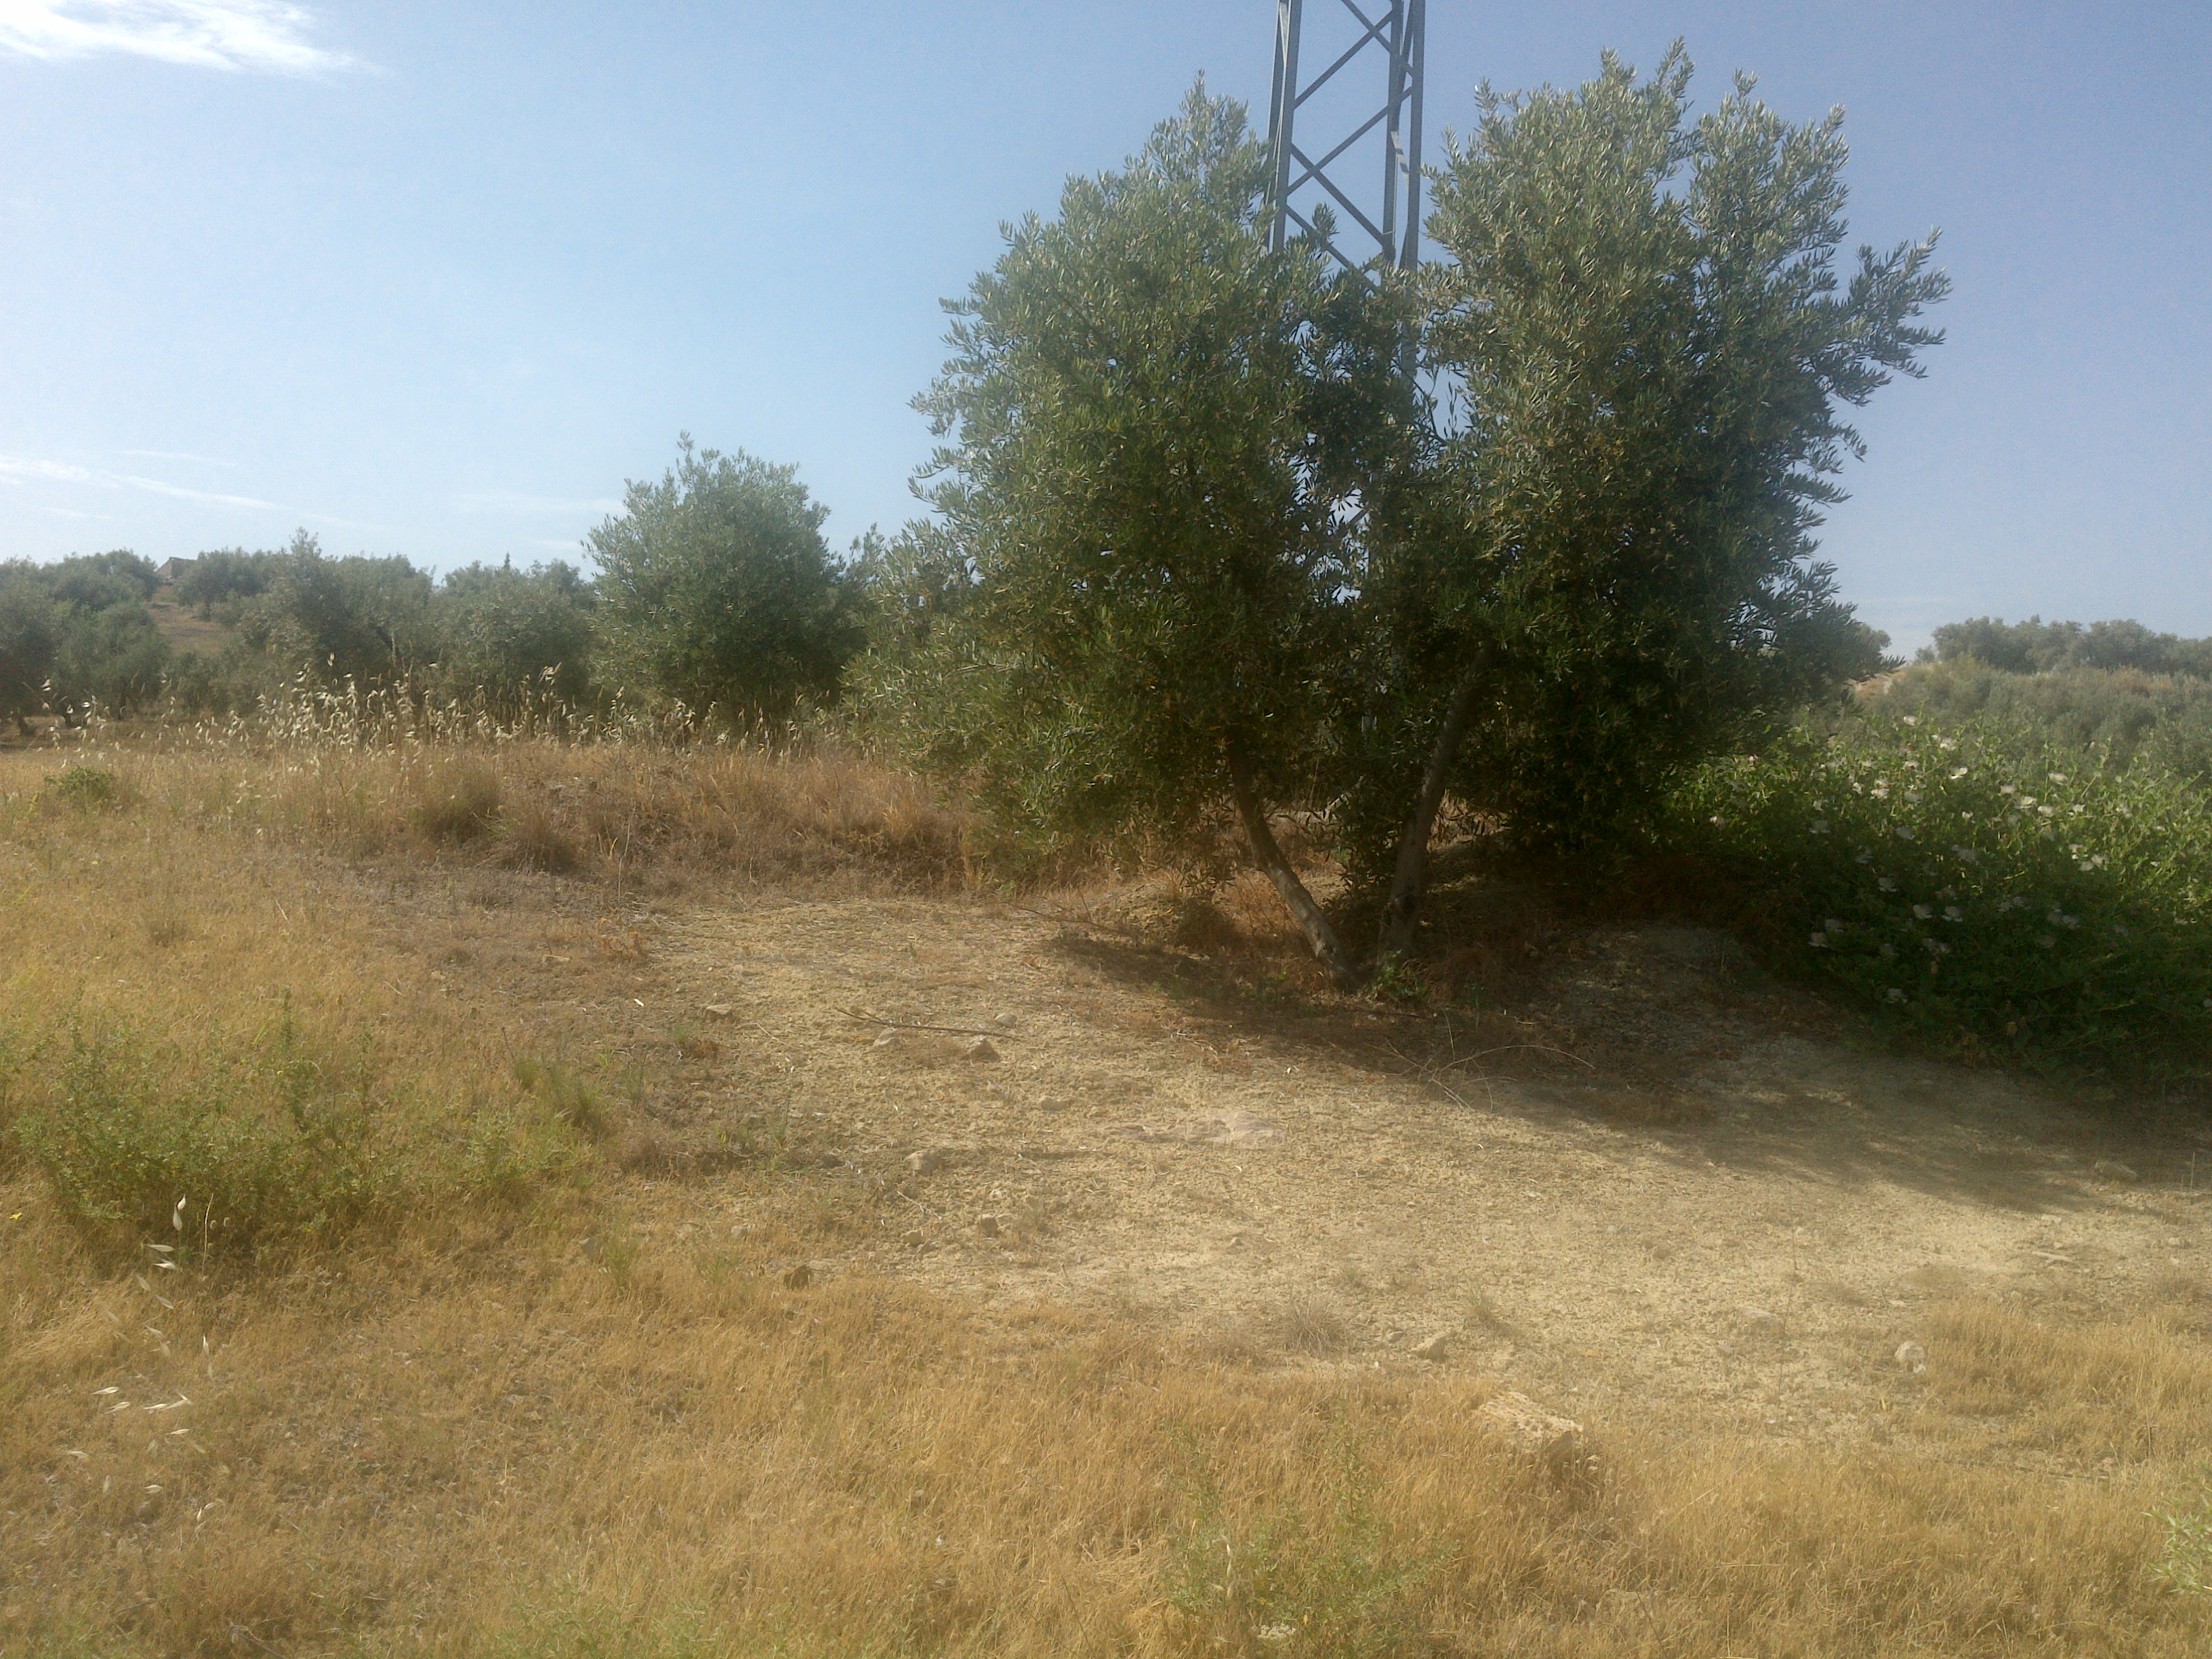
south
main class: Cropland
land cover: Olive groves
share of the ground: 10 - 25 %
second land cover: Spontaneously vegetated surfaces
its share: 50 - 75 %
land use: Agriculture (excluding fallow land and kitchen gardens)
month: May
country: ES
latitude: 37.5168
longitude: -4.1087
